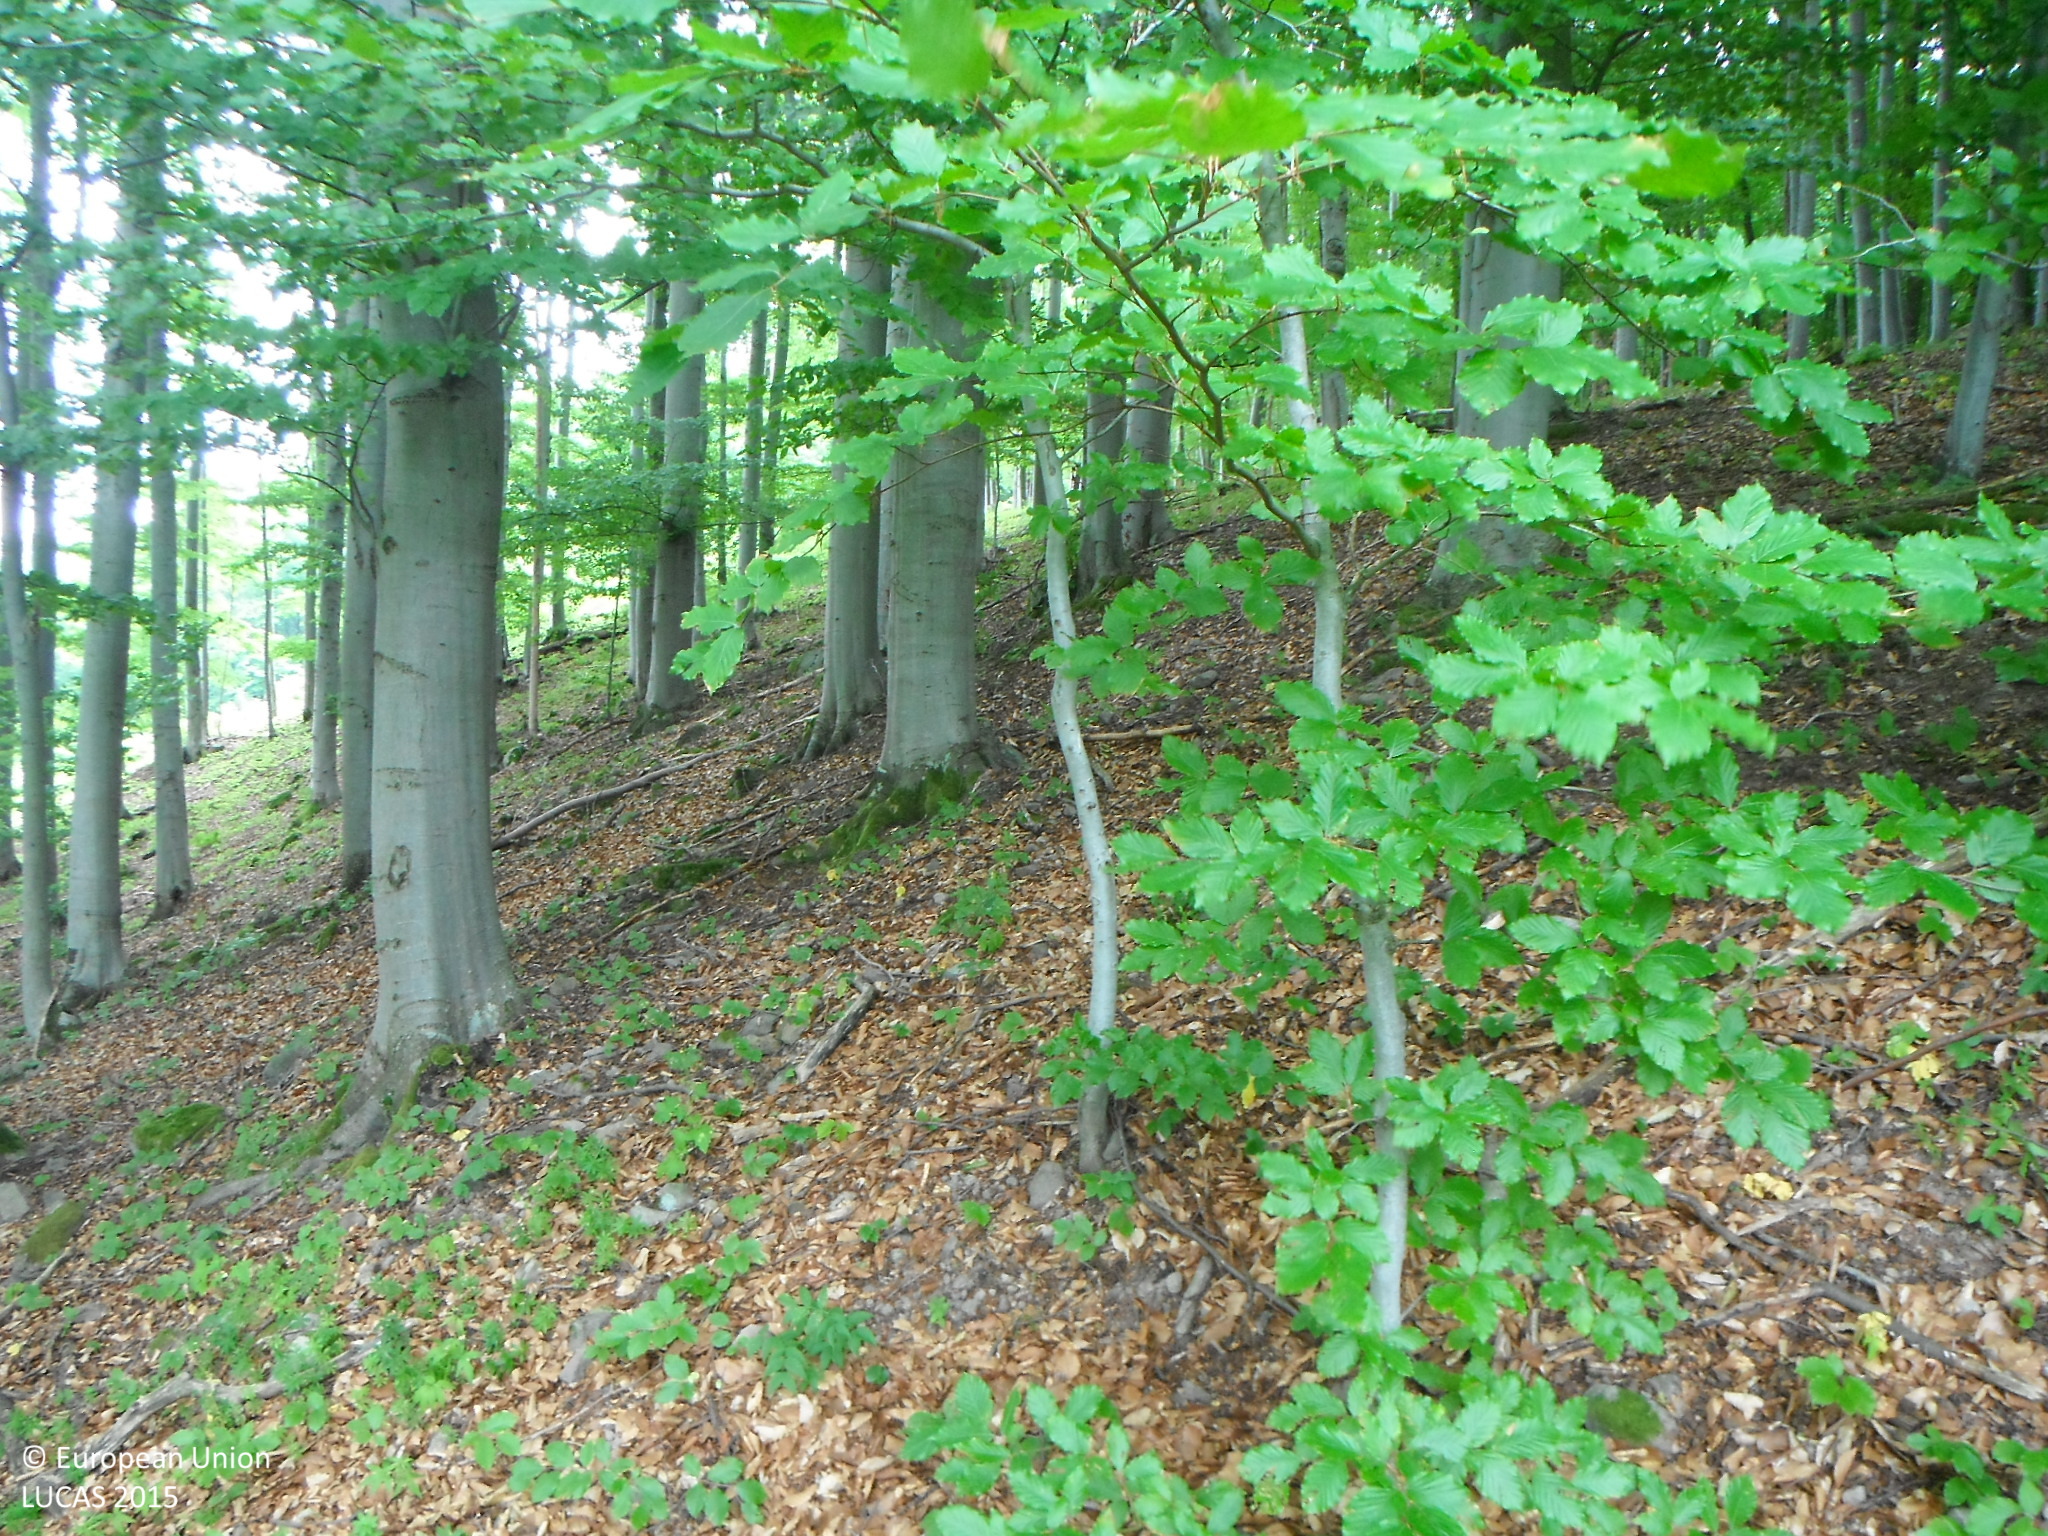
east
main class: Woodland
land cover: Broadleaved woodland
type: mountainous beech forest
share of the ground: > 75 %
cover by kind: broadleaved forest trees 90 %, herbaceous plants 10 %
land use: Forestry
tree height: > 5 m
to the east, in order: Broadleaved woodland
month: June
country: SK
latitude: 48.6429
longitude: 19.3204
